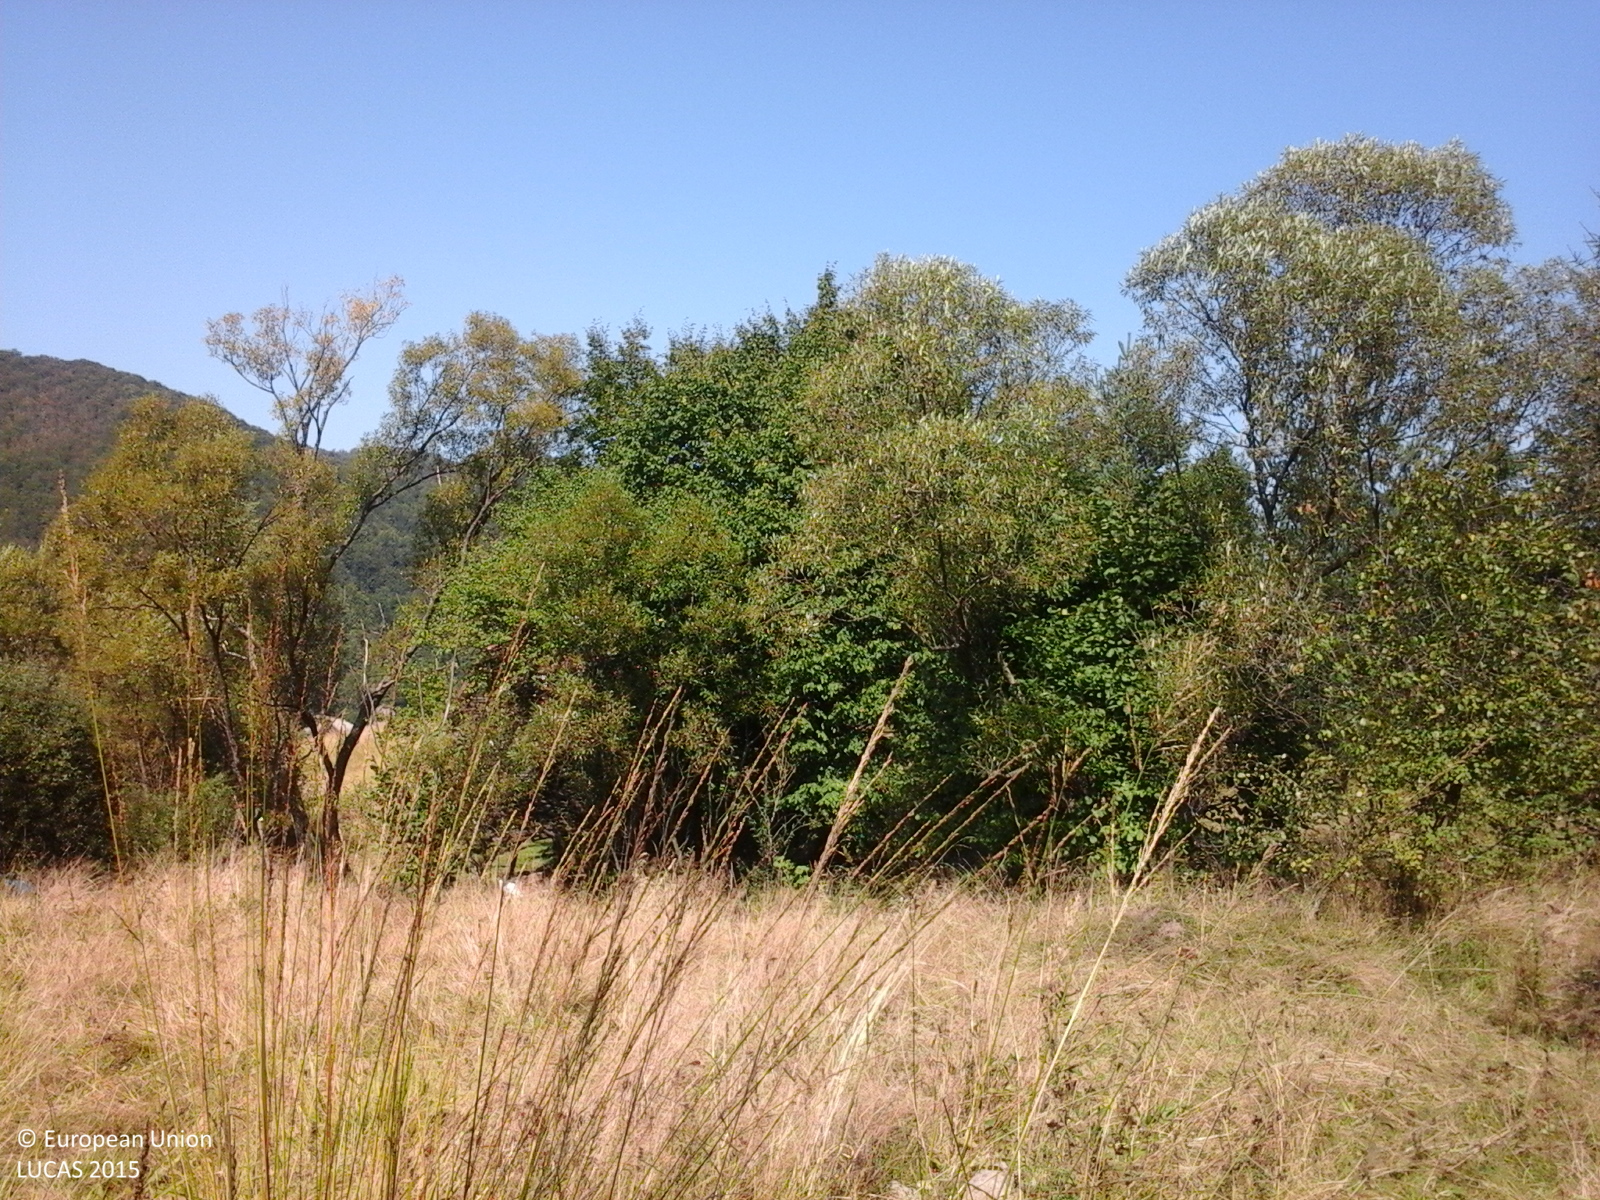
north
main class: Grassland
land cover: Grassland with sparse tree/shrub cover
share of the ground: > 75 %
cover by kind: herbaceous plants 85 %, shrubs 10 %, broadleaved forest trees 5 %
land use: Agriculture (excluding fallow land and kitchen gardens)
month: September
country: RO
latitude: 46.7910
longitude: 22.5648
